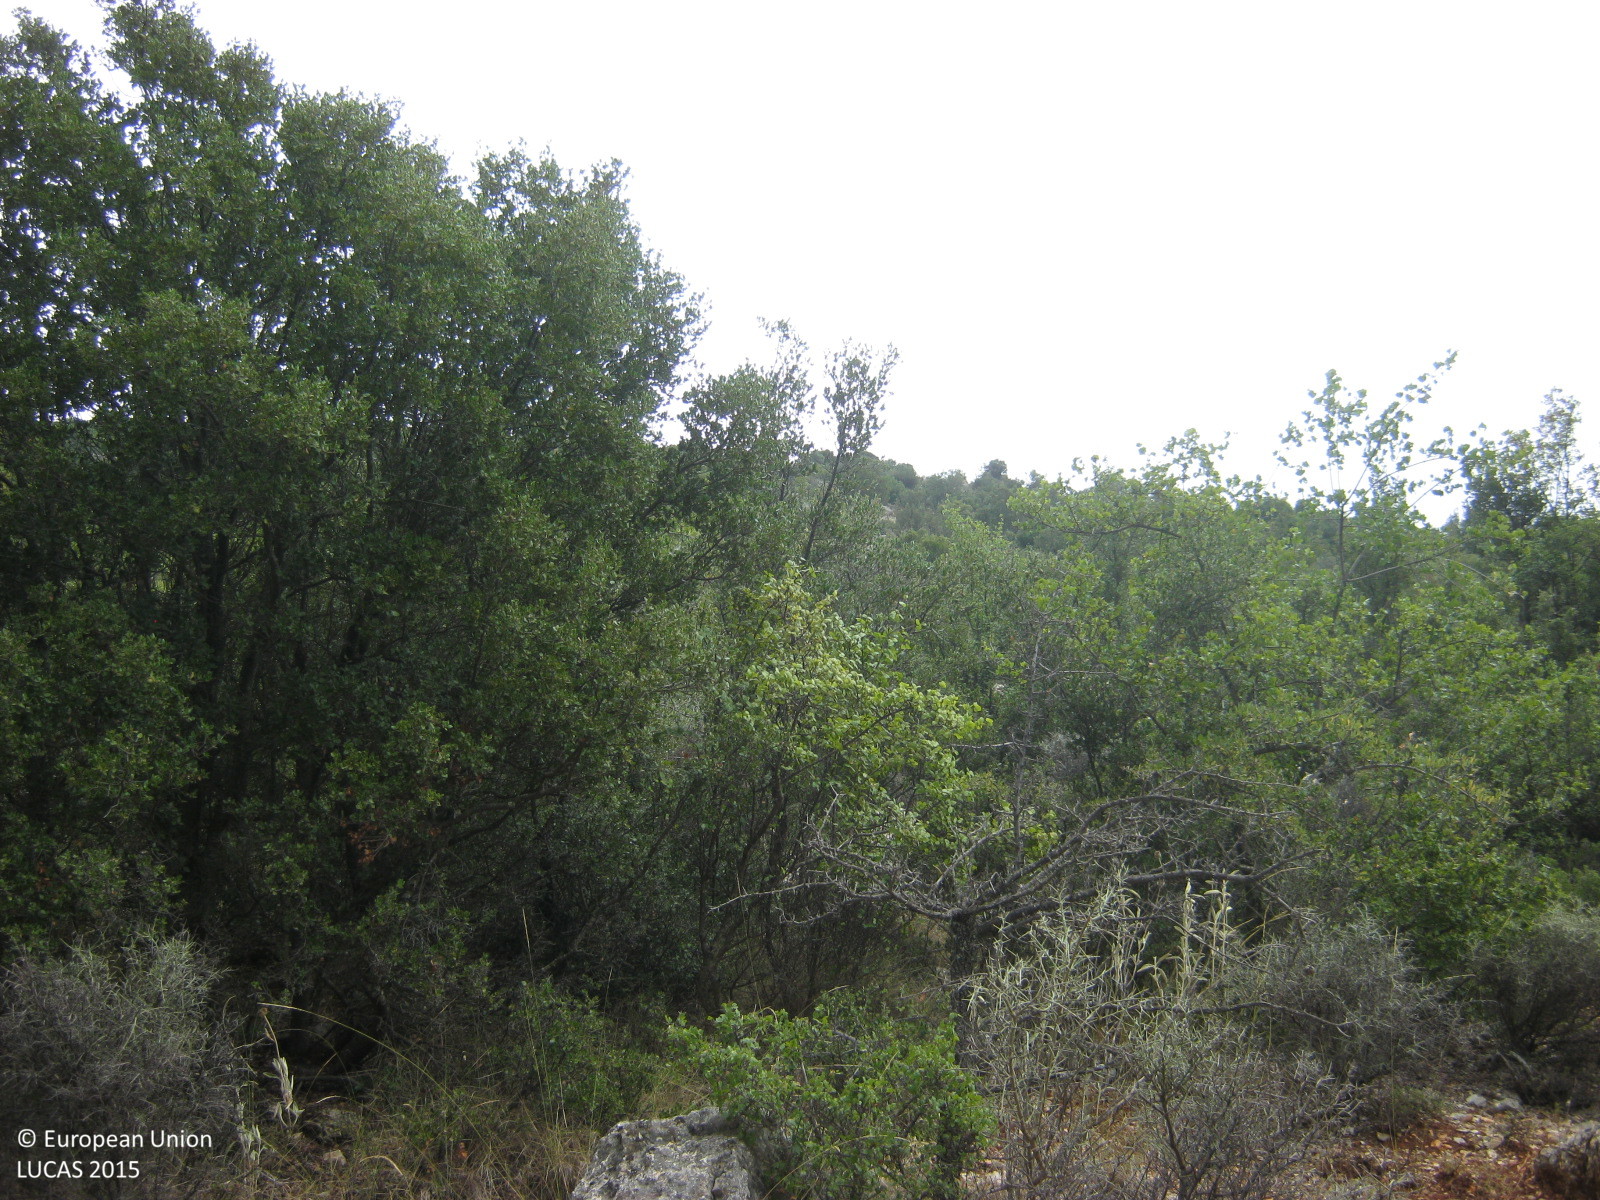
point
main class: Shrubland
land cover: Shrubland with sparse tree cover
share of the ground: 50 - 75 %
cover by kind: shrubs 50 %, unconsolidated bare surface 45 %, broadleaved forest trees 5 %
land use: Semi-natural and natural areas not in use
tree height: < 5 m
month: September
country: GR
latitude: 37.2782
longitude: 22.6939
